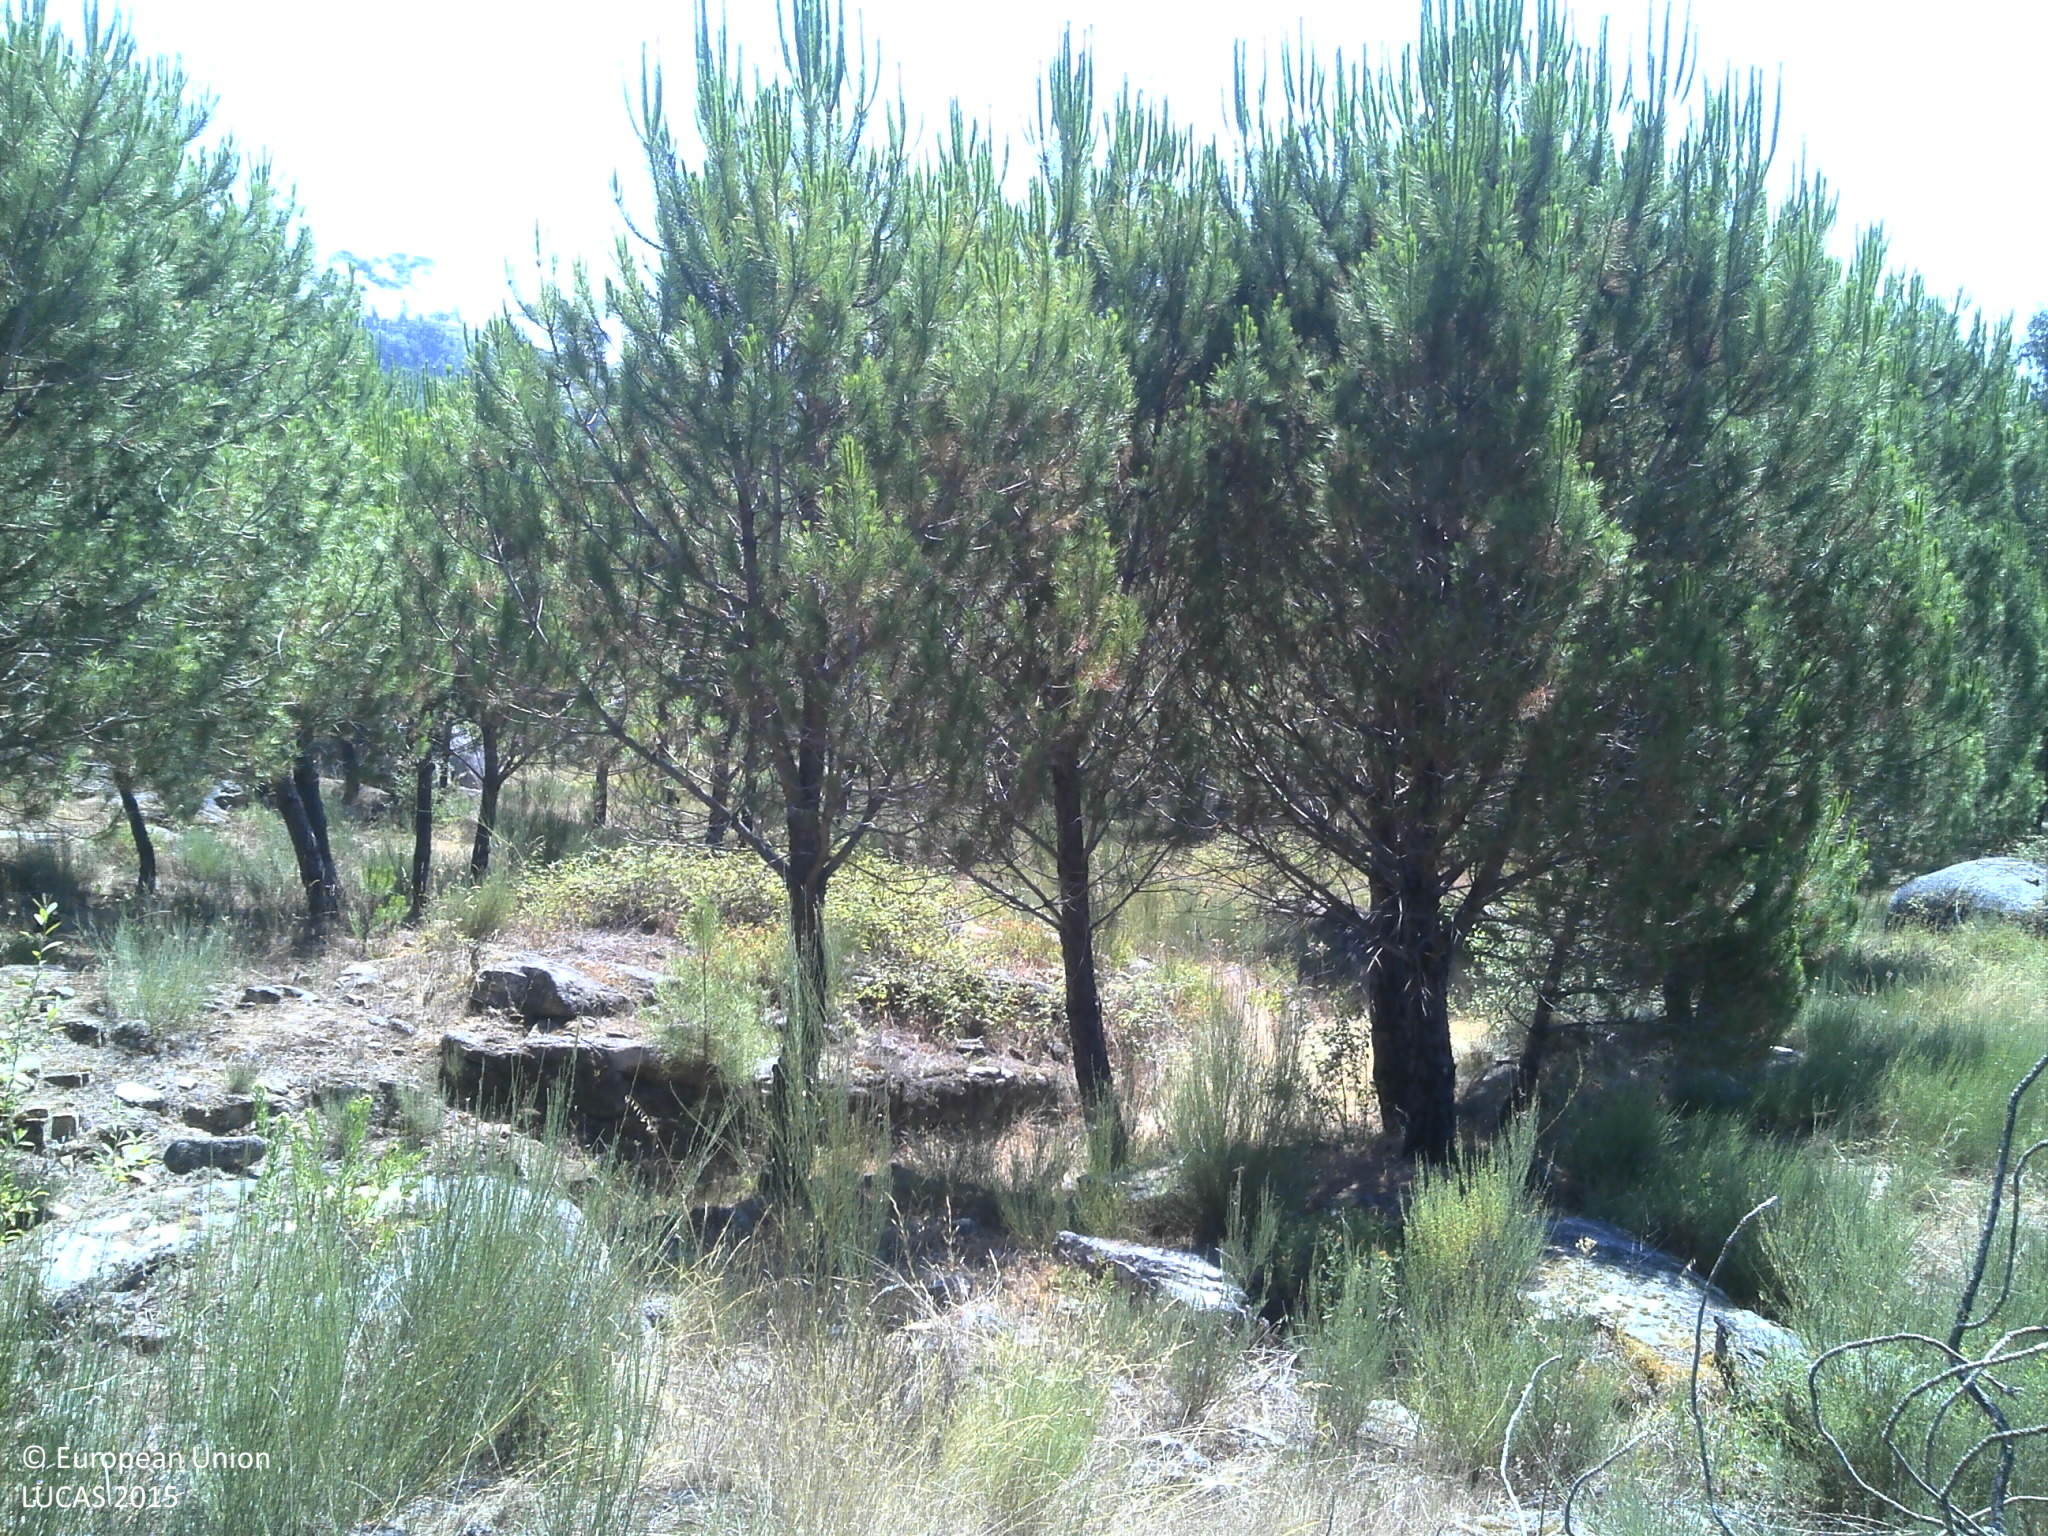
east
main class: Woodland
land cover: Pine dominated coniferous woodland
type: coniferous forest of the mediterranean region
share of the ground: 25 - 50 %
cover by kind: coniferous forest trees 45 %, herbaceous plants 25 %, shrubs 10 %, consolidated bare surface 10 %, unconsolidated bare surface 10 %
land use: Forestry
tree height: > 5 m
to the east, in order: Pine dominated coniferous woodland; Rock outcrops; Pine dominated coniferous woodland; Tracks; Shrubland with sparse tree cover; Pine dominated coniferous woodland; Dry stone walls; Shrubland with sparse tree cover; Shrubland without tree cover; Broadleaved woodland; Shrubland without tree cover; Pine dominated coniferous woodland; Grassland without tree/shrub cover; Tracks; Shrubland with sparse tree cover; Dry stone walls
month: June
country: PT
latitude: 40.5329
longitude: -7.7677
